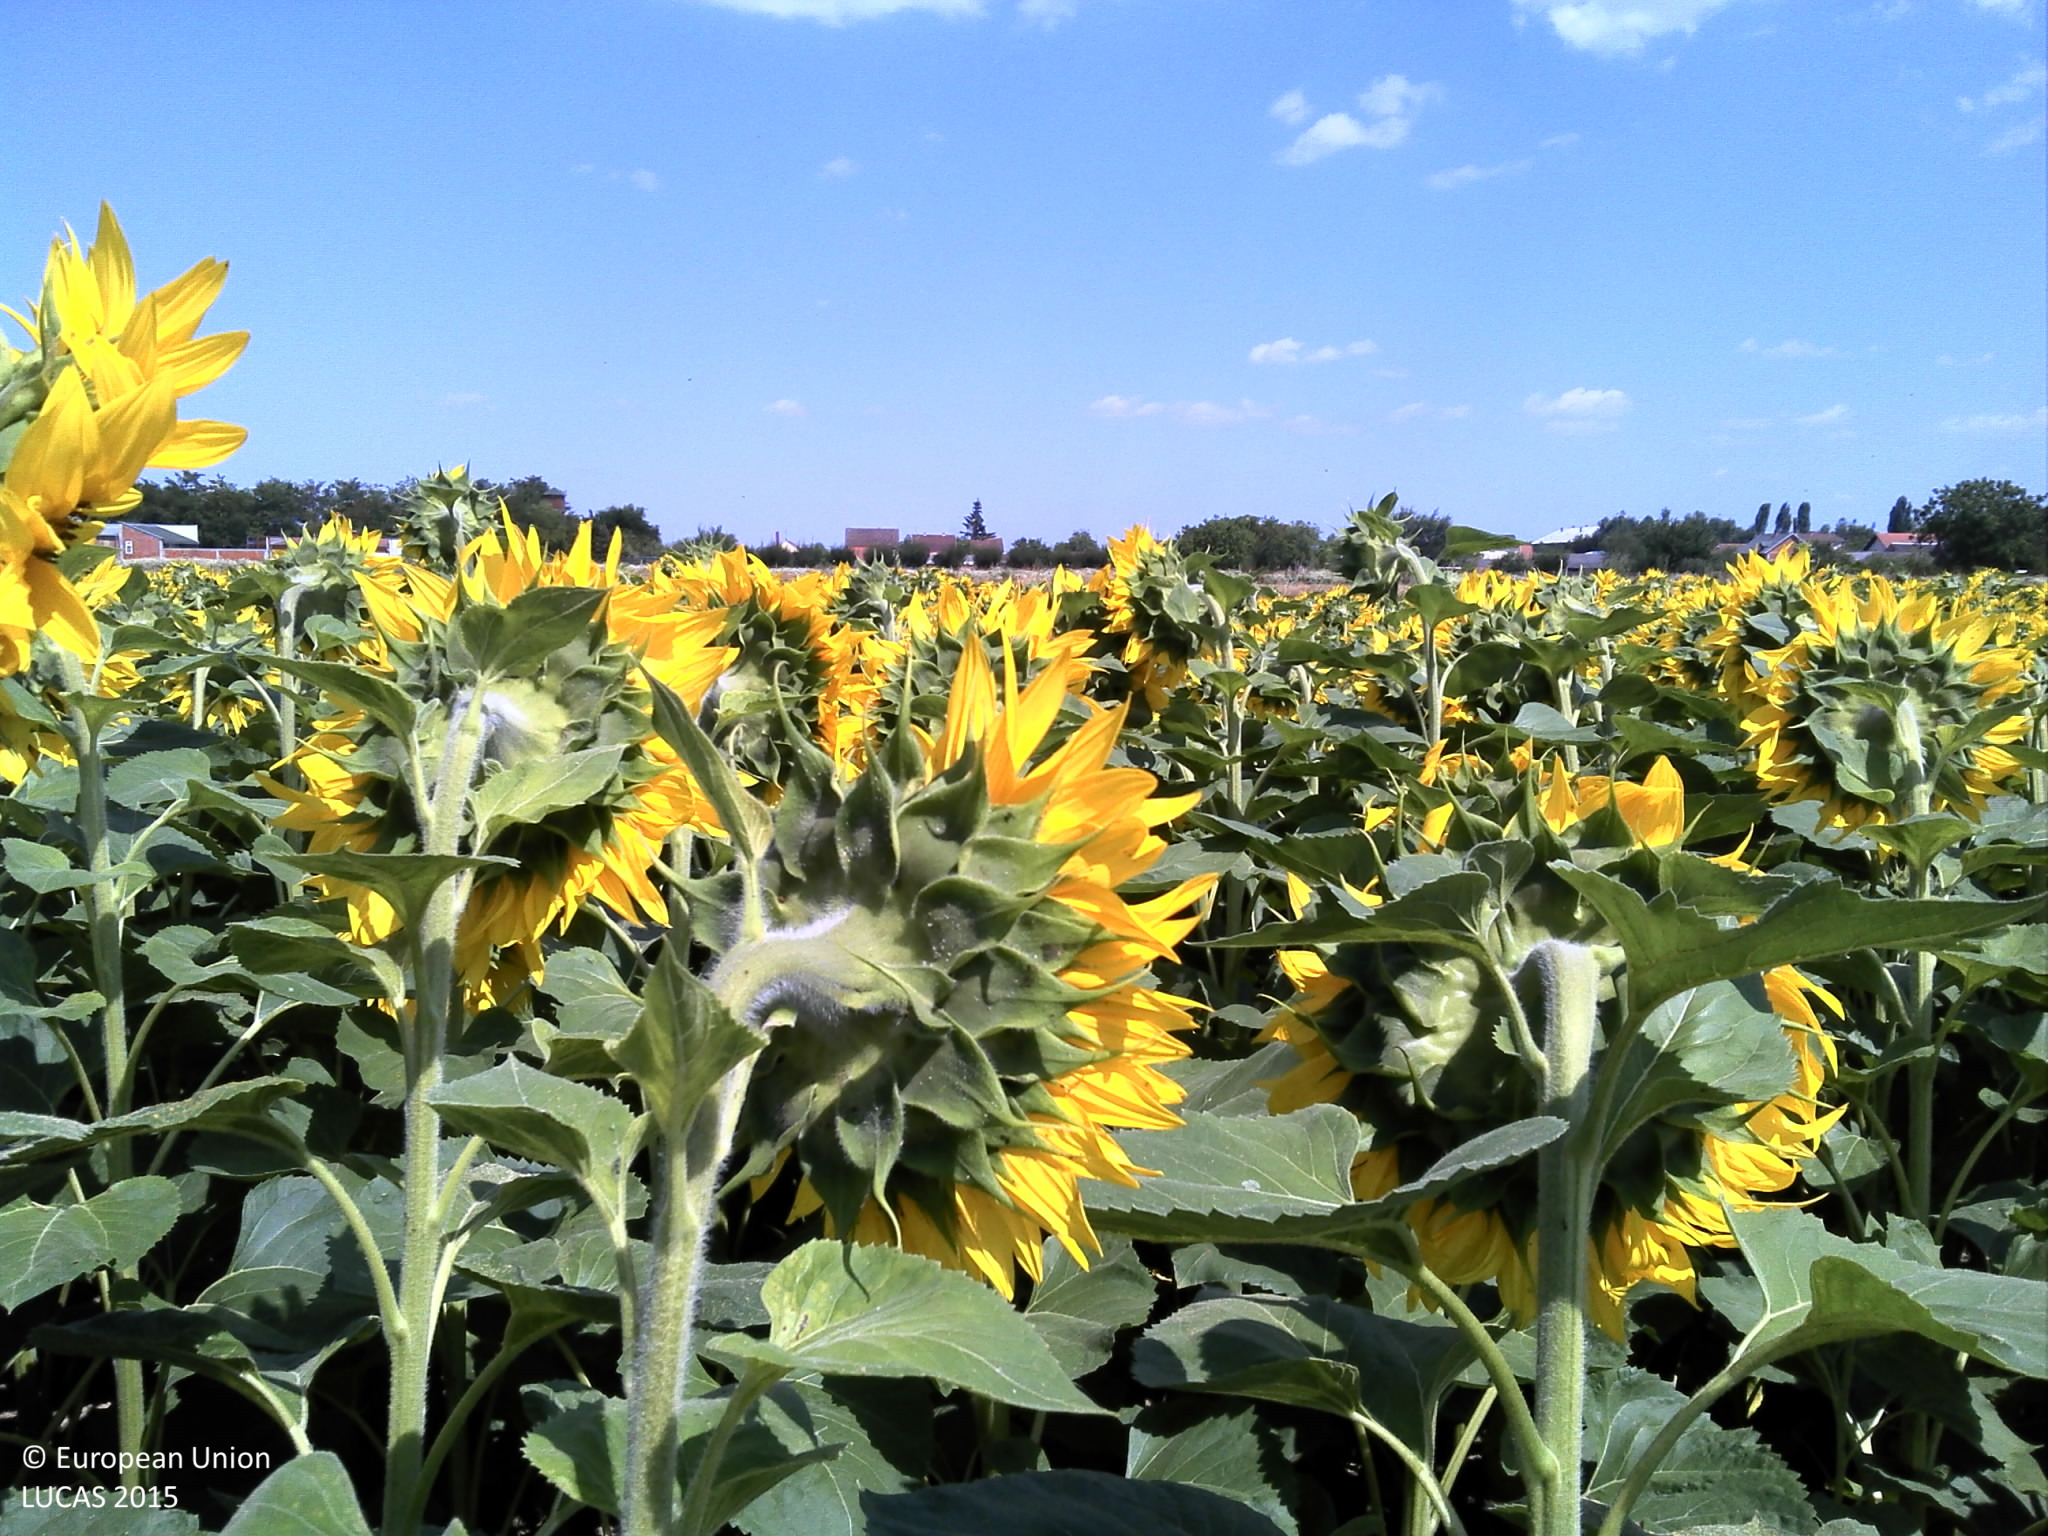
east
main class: Cropland
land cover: Sunflower
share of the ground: > 75 %
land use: Agriculture (excluding fallow land and kitchen gardens)
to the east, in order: Sunflower; Ditches and canals; Maize; Grassland without tree/shrub cover; Common wheat; Rape and turnip rape; Grassland without tree/shrub cover; Oats; Common wheat; Fences; Other fruit trees and berries; Fences; Barley; Tracks
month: July
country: HR
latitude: 45.3311
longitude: 18.4137
